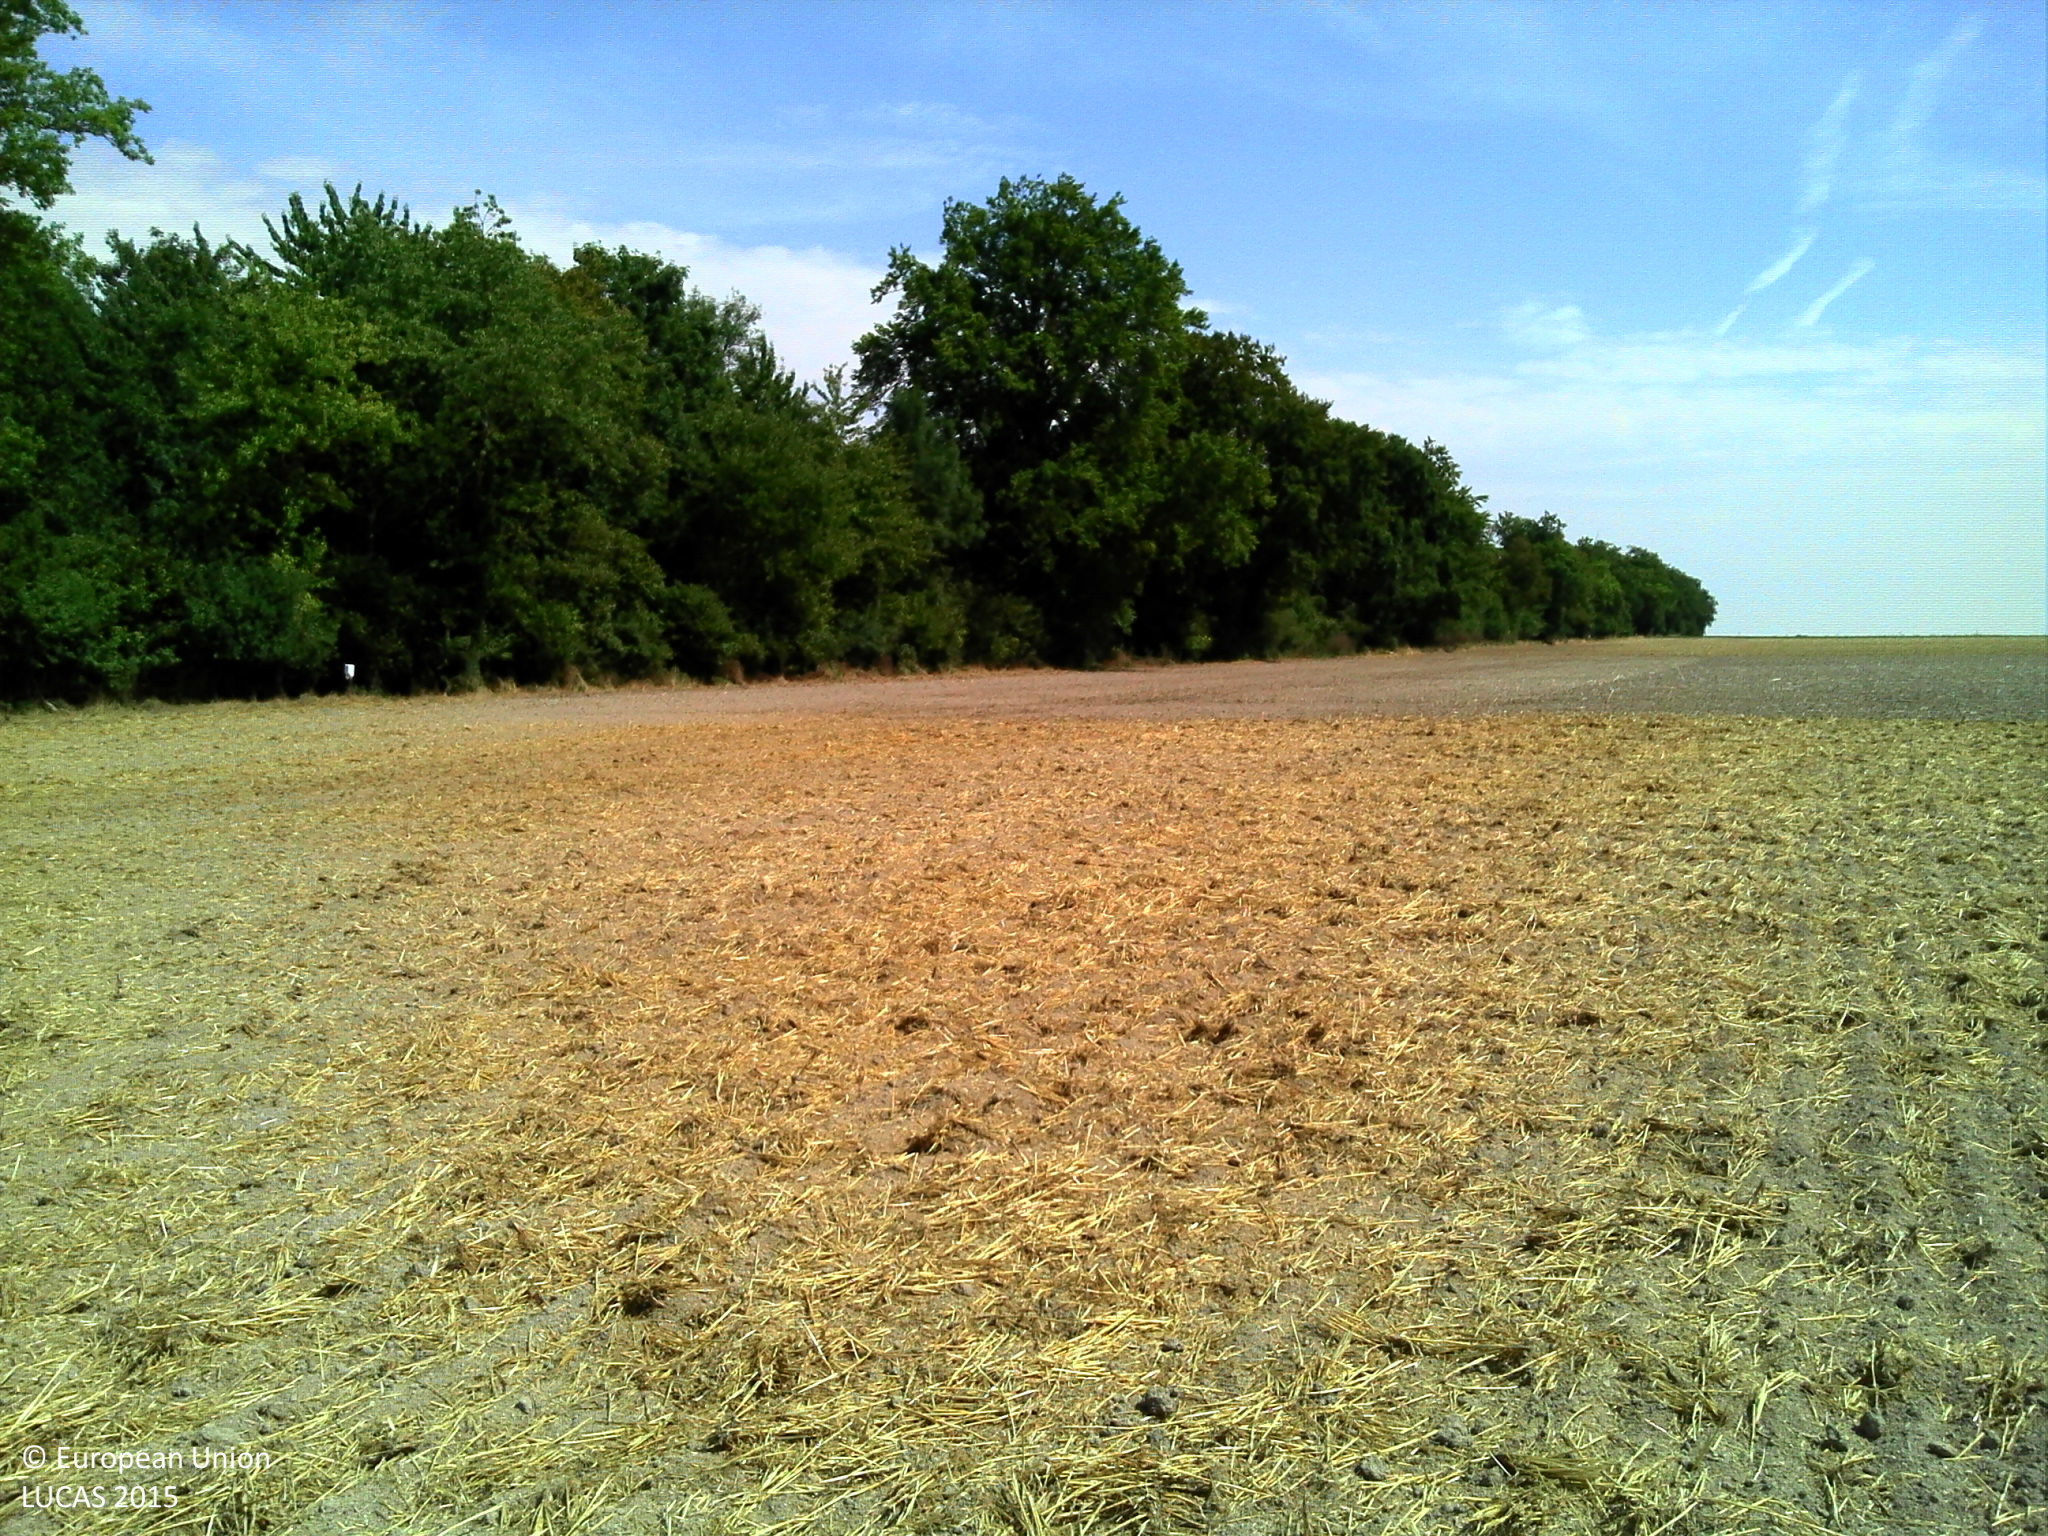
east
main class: Cropland
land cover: Common wheat
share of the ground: > 75 %
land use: Agriculture (excluding fallow land and kitchen gardens)
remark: Harvested field
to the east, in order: Common wheat; Rape and turnip rape; Broadleaved woodland; Grass margins; Common wheat
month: August
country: FR
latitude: 48.9722
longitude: 4.1898
